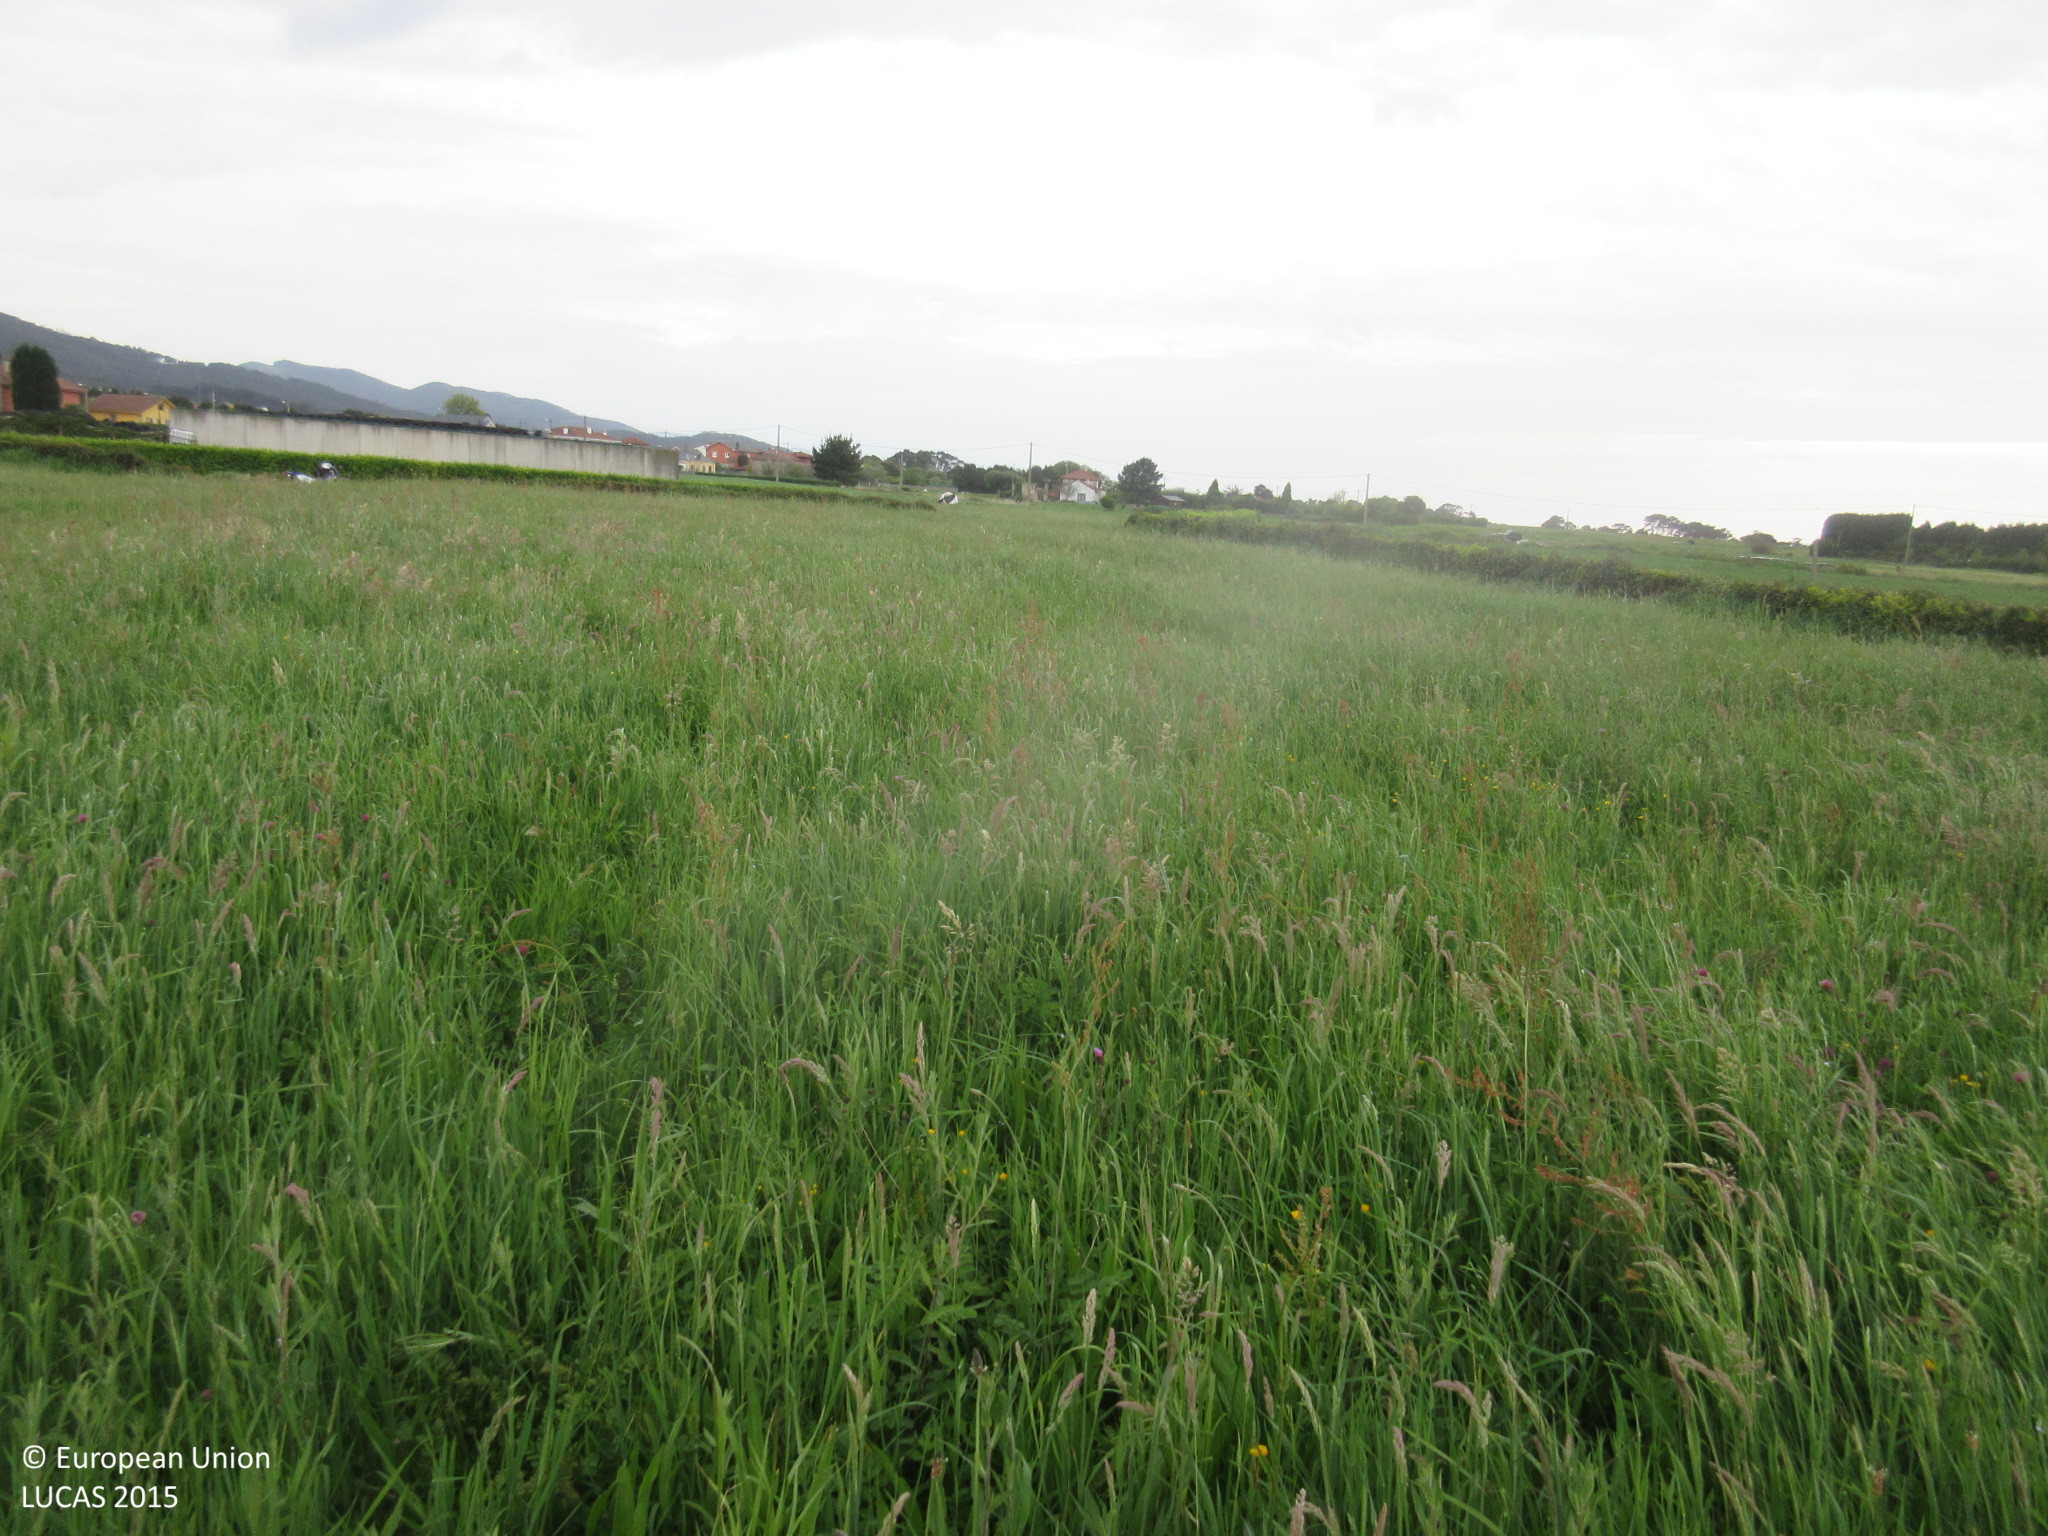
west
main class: Grassland
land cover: Grassland without tree/shrub cover
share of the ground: > 75 %
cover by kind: herbaceous plants 100 %
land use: Agriculture (excluding fallow land and kitchen gardens)
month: April
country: ES
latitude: 43.5528
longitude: -6.3797
